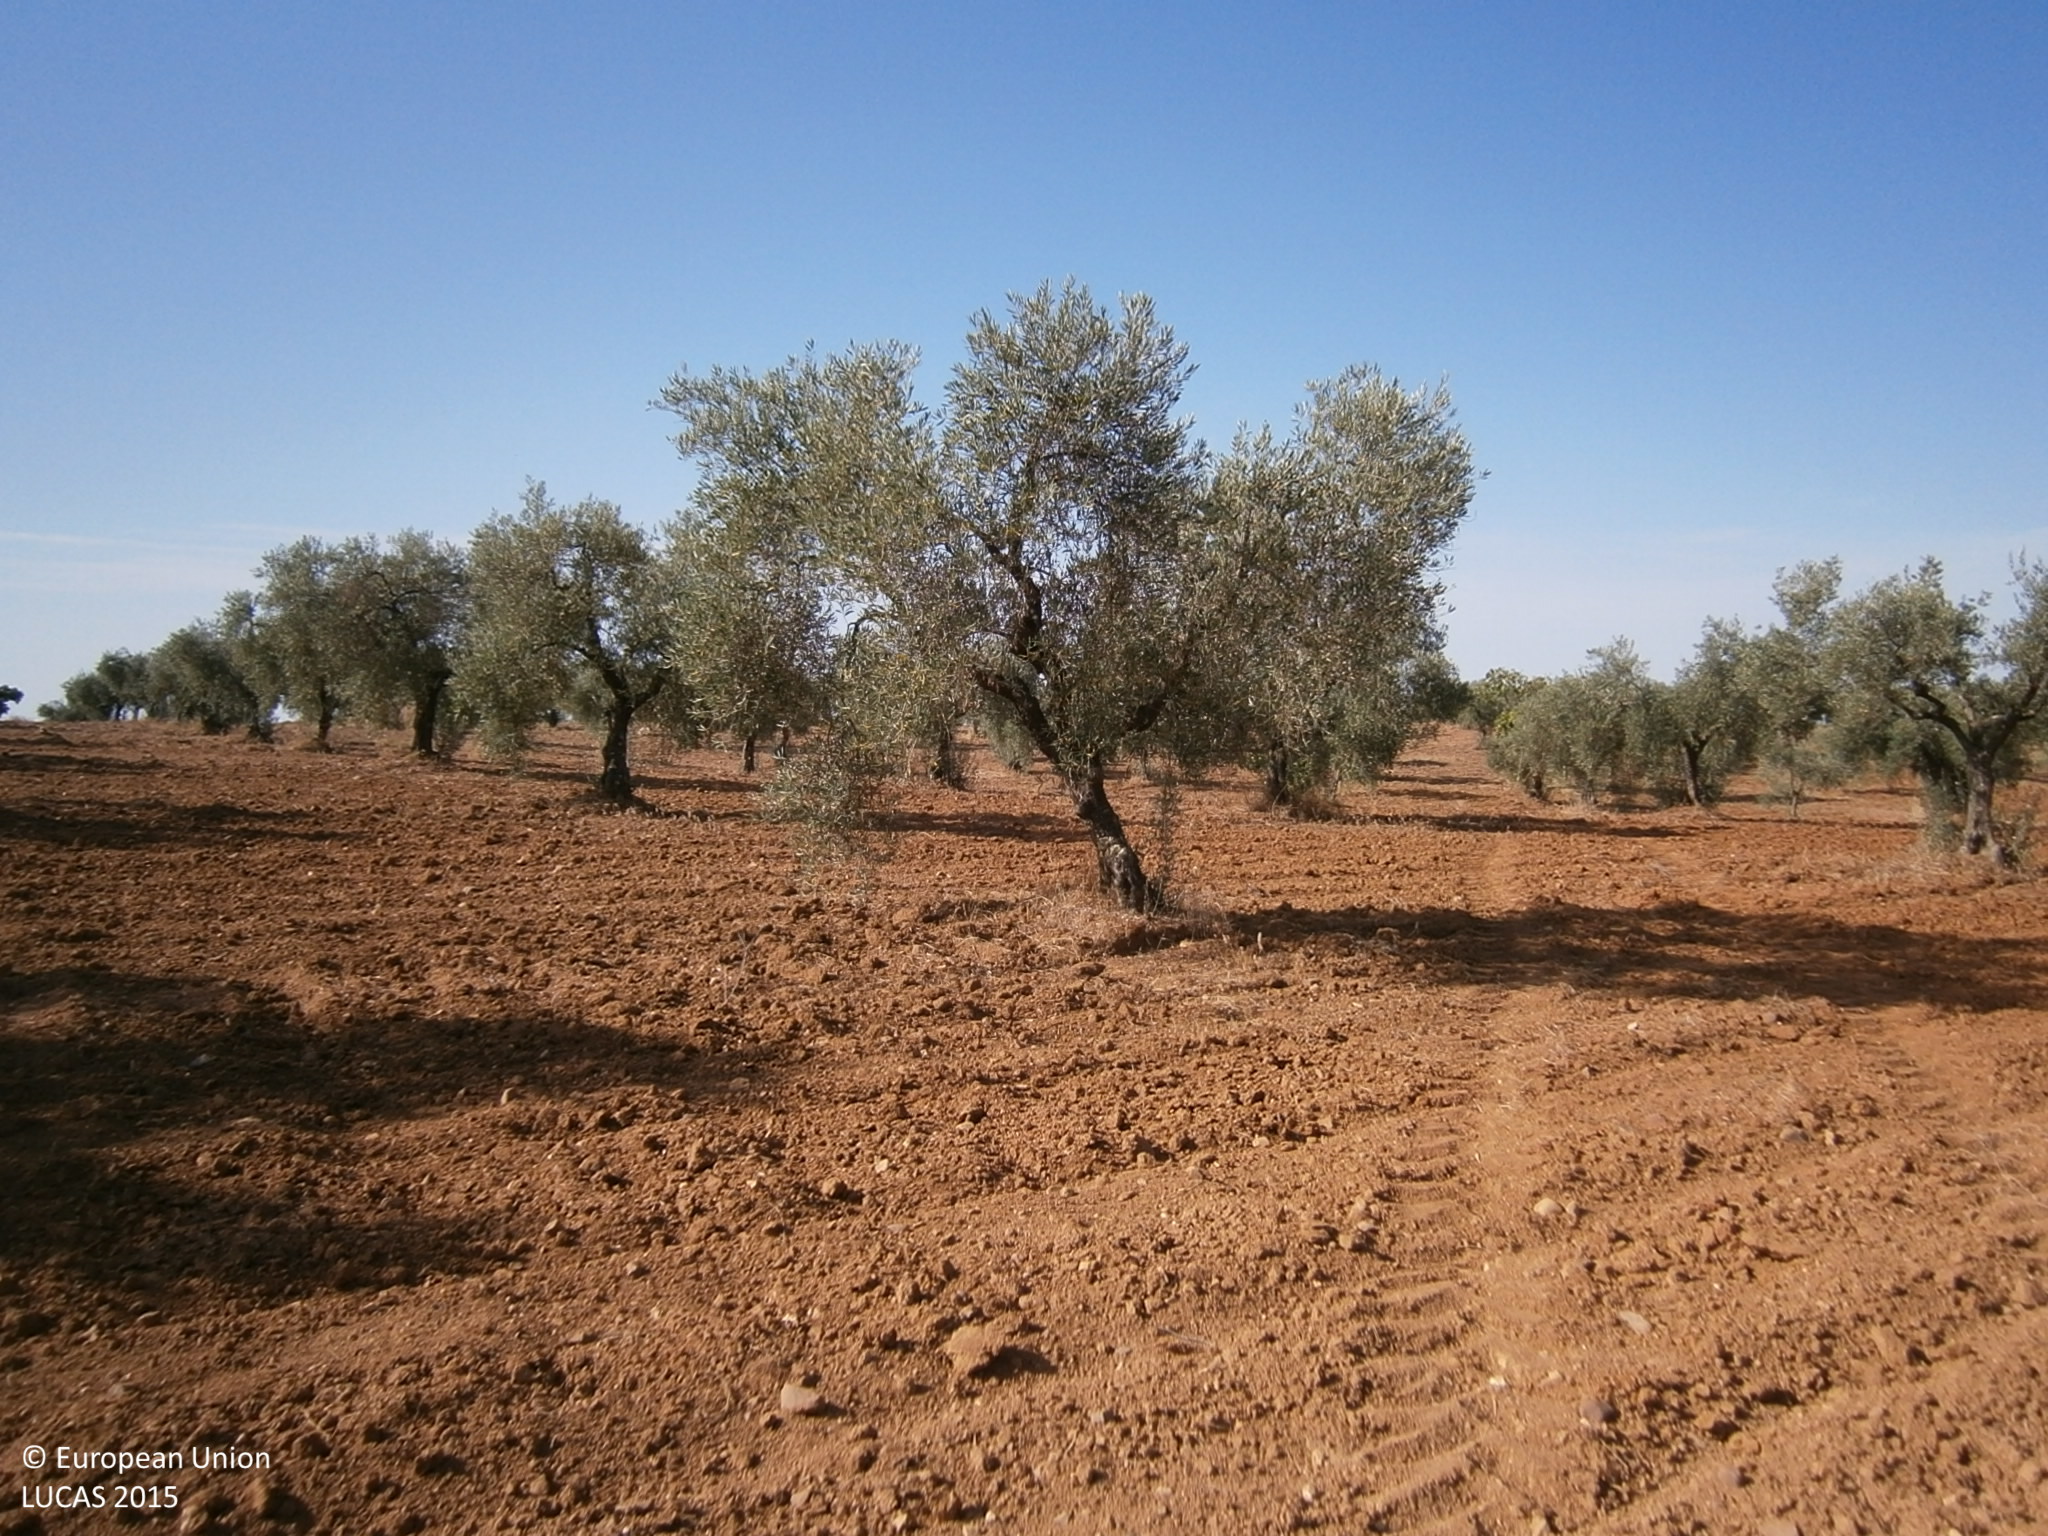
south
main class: Cropland
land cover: Olive groves
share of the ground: 25 - 50 %
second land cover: Other bare soil
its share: > 75 %
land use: Agriculture (excluding fallow land and kitchen gardens)
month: July
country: ES
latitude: 39.0605
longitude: -6.7208
